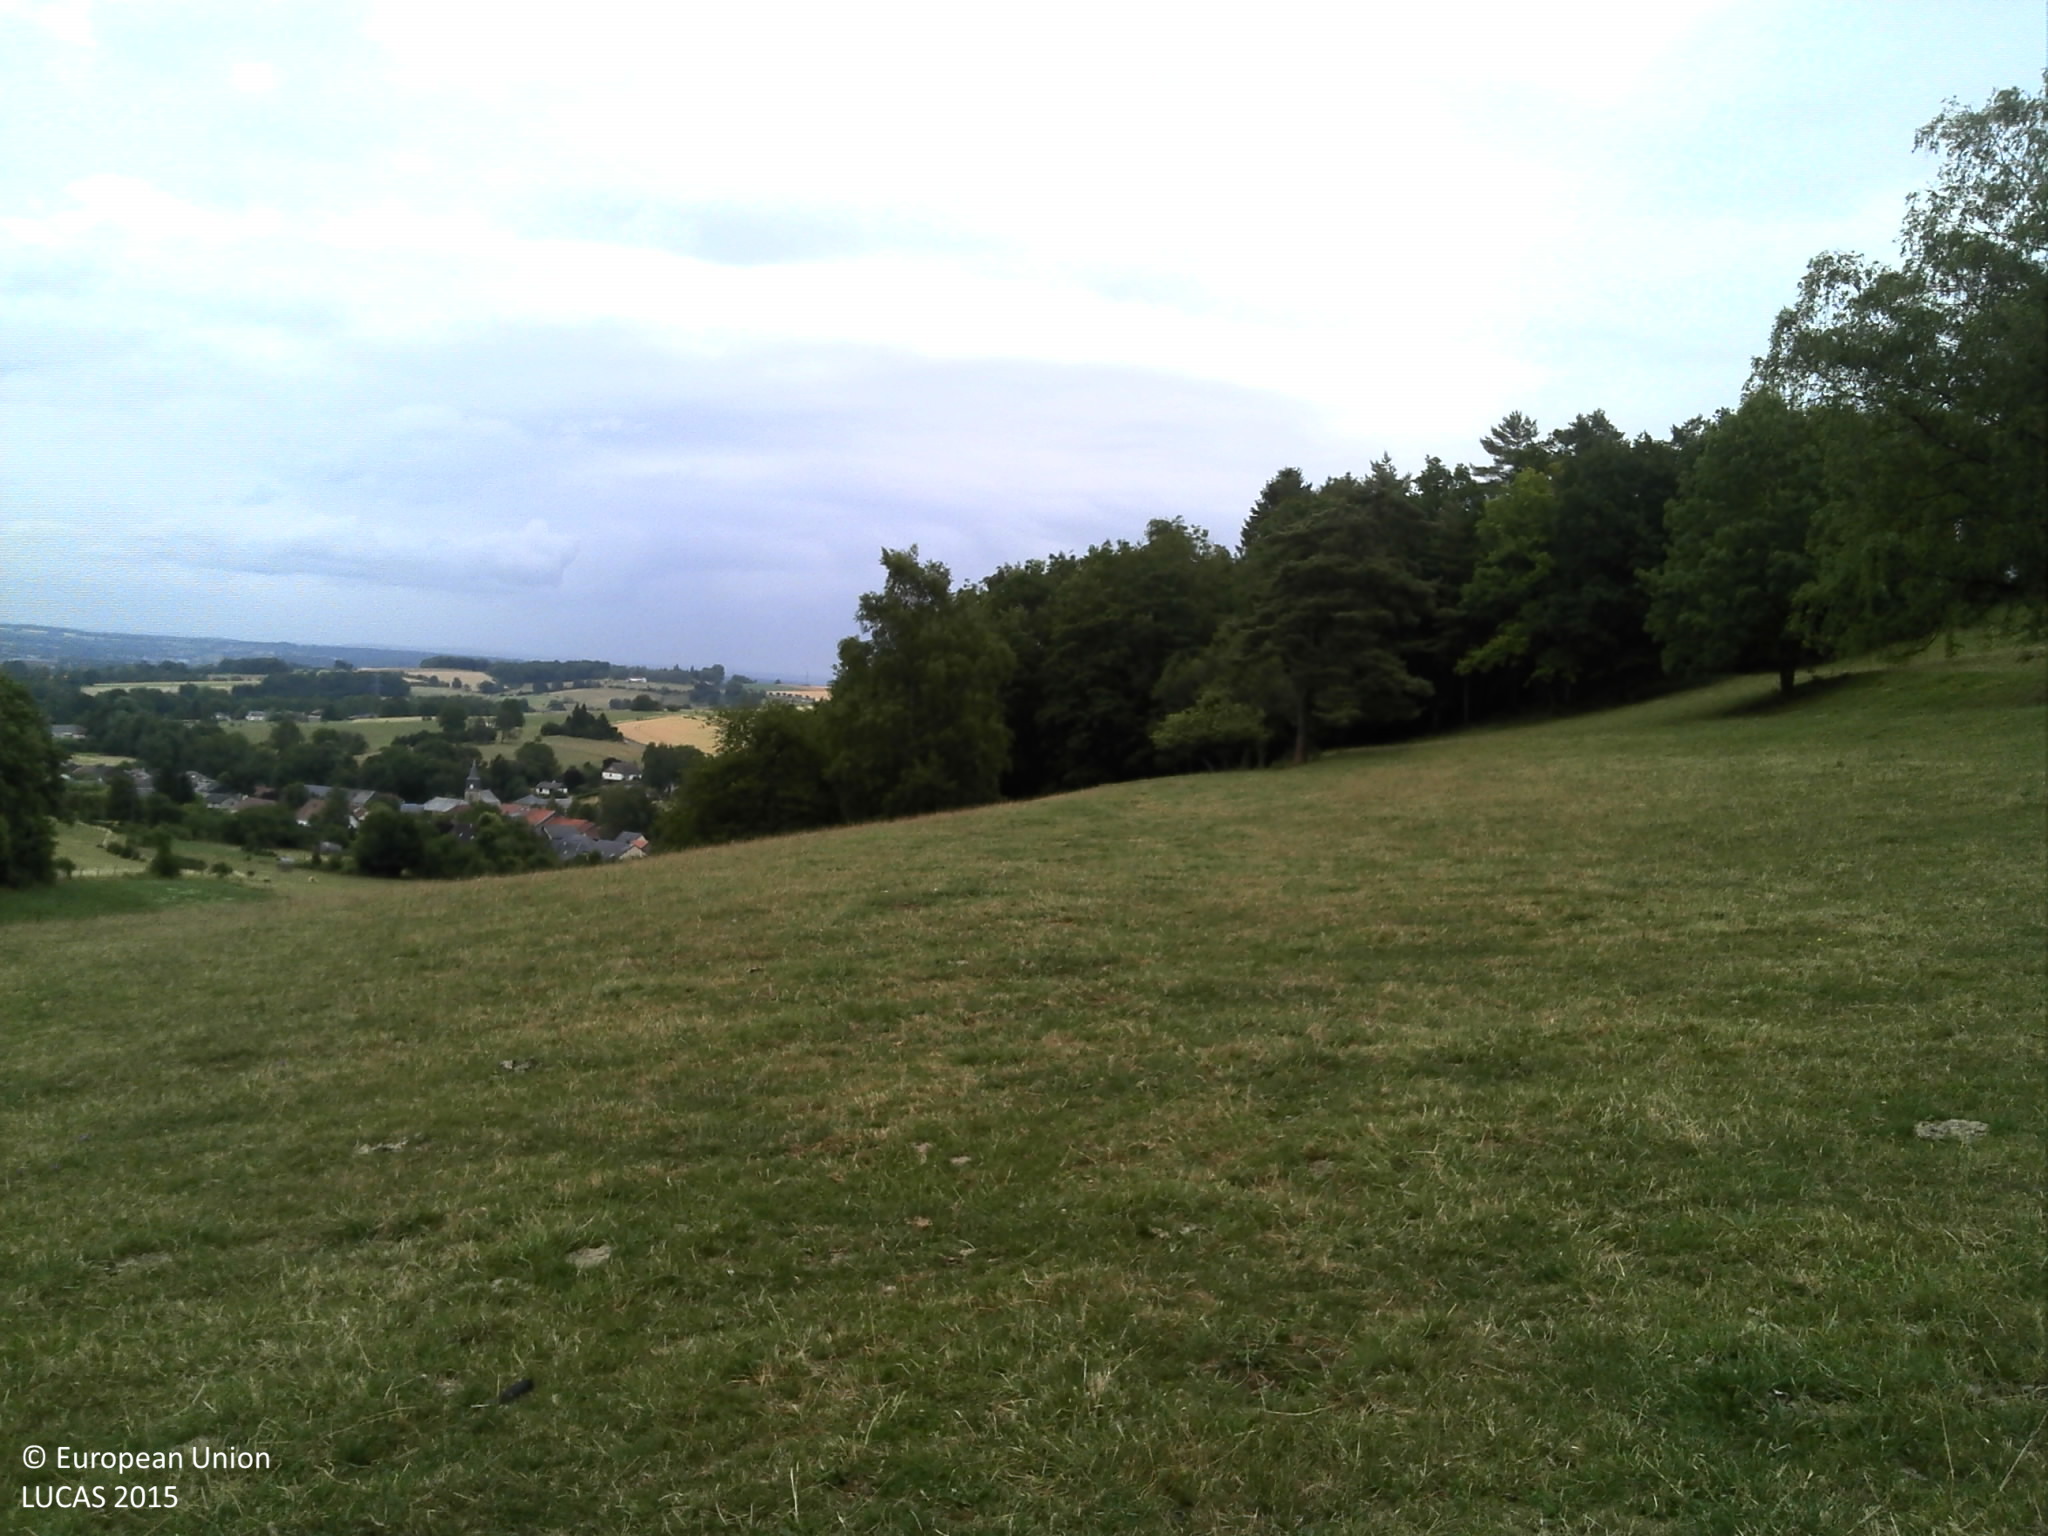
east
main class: Grassland
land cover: Grassland without tree/shrub cover
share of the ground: > 75 %
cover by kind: herbaceous plants 100 %
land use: Agriculture (excluding fallow land and kitchen gardens)
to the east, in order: Grassland without tree/shrub cover; Broadleaved woodland; Fences; Grassland without tree/shrub cover
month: July
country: FR
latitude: 49.7332
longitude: 4.6271
